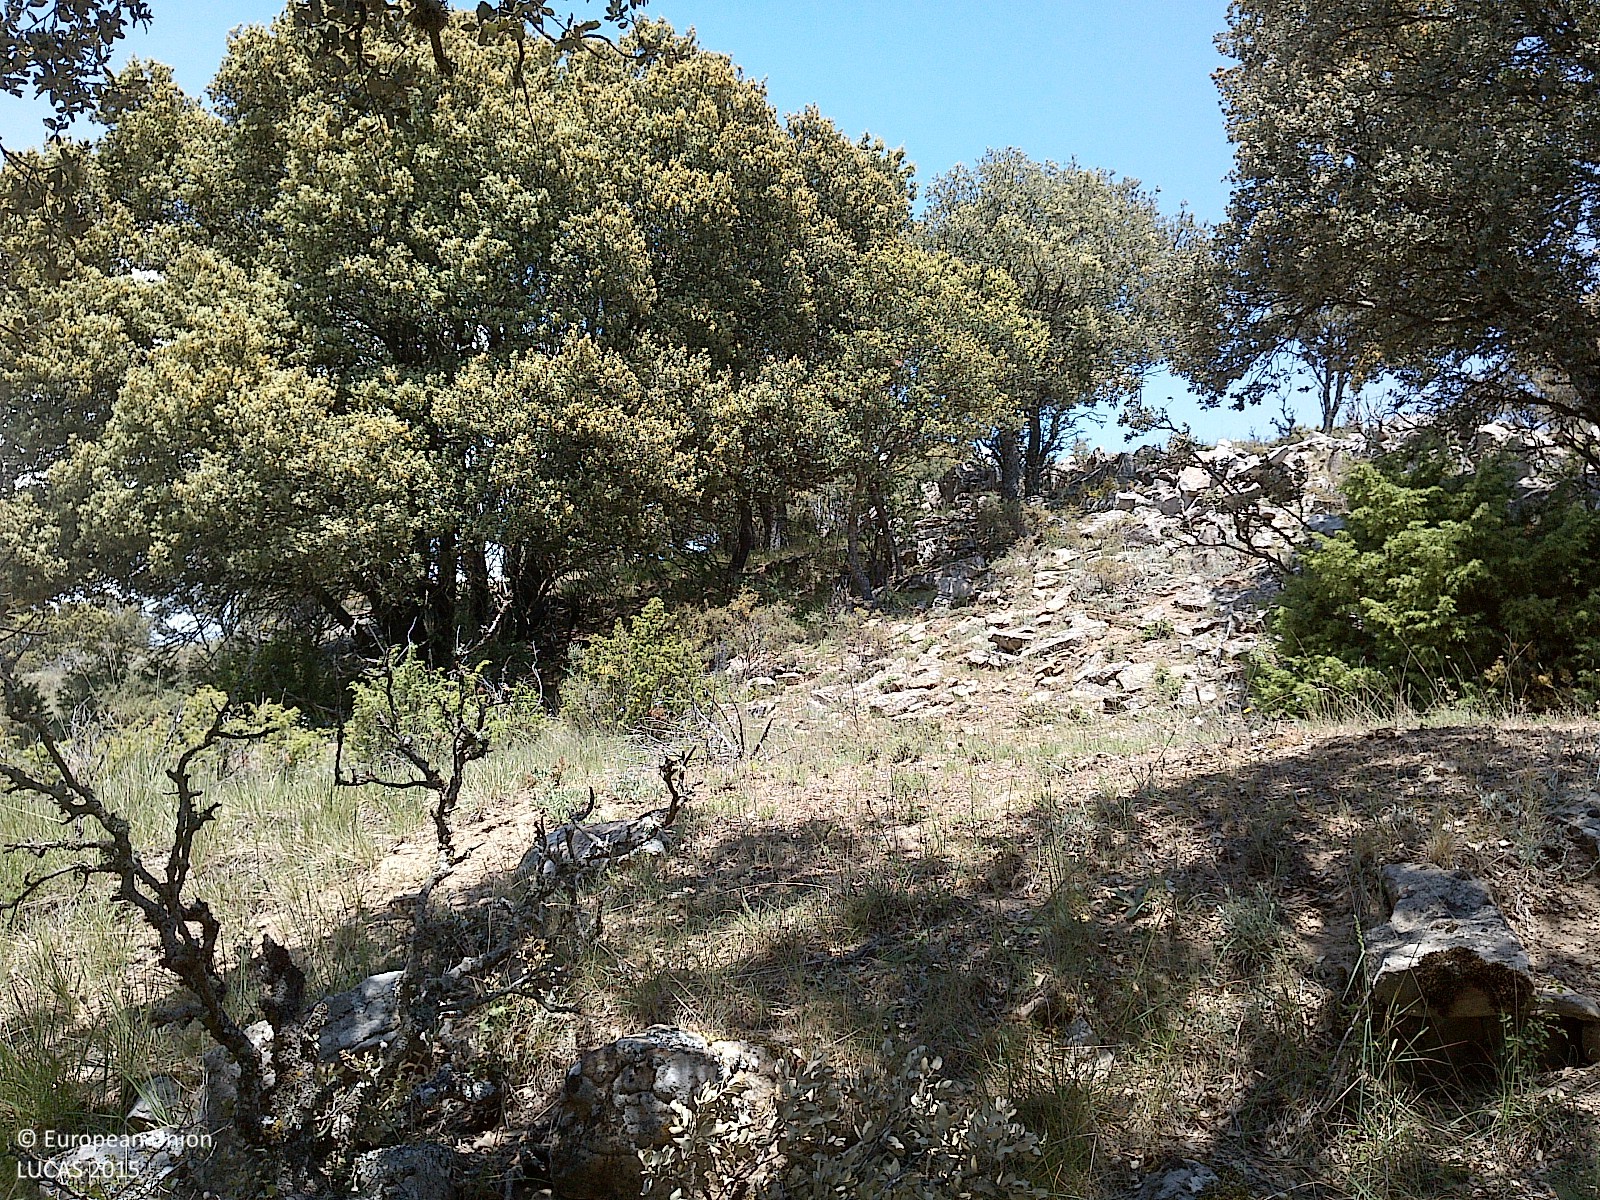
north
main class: Woodland
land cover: Broadleaved woodland
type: broadleaved evergreen forest
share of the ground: 25 - 50 %
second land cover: Grassland without tree/shrub cover
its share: 50 - 75 %
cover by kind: broadleaved forest trees 45 %, herbaceous plants 35 %, consolidated bare surface 15 %, shrubs 5 %
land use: Forestry
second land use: Agriculture (excluding fallow land and kitchen gardens)
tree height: < 5 m
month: May
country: ES
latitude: 41.8571
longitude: -2.2145
